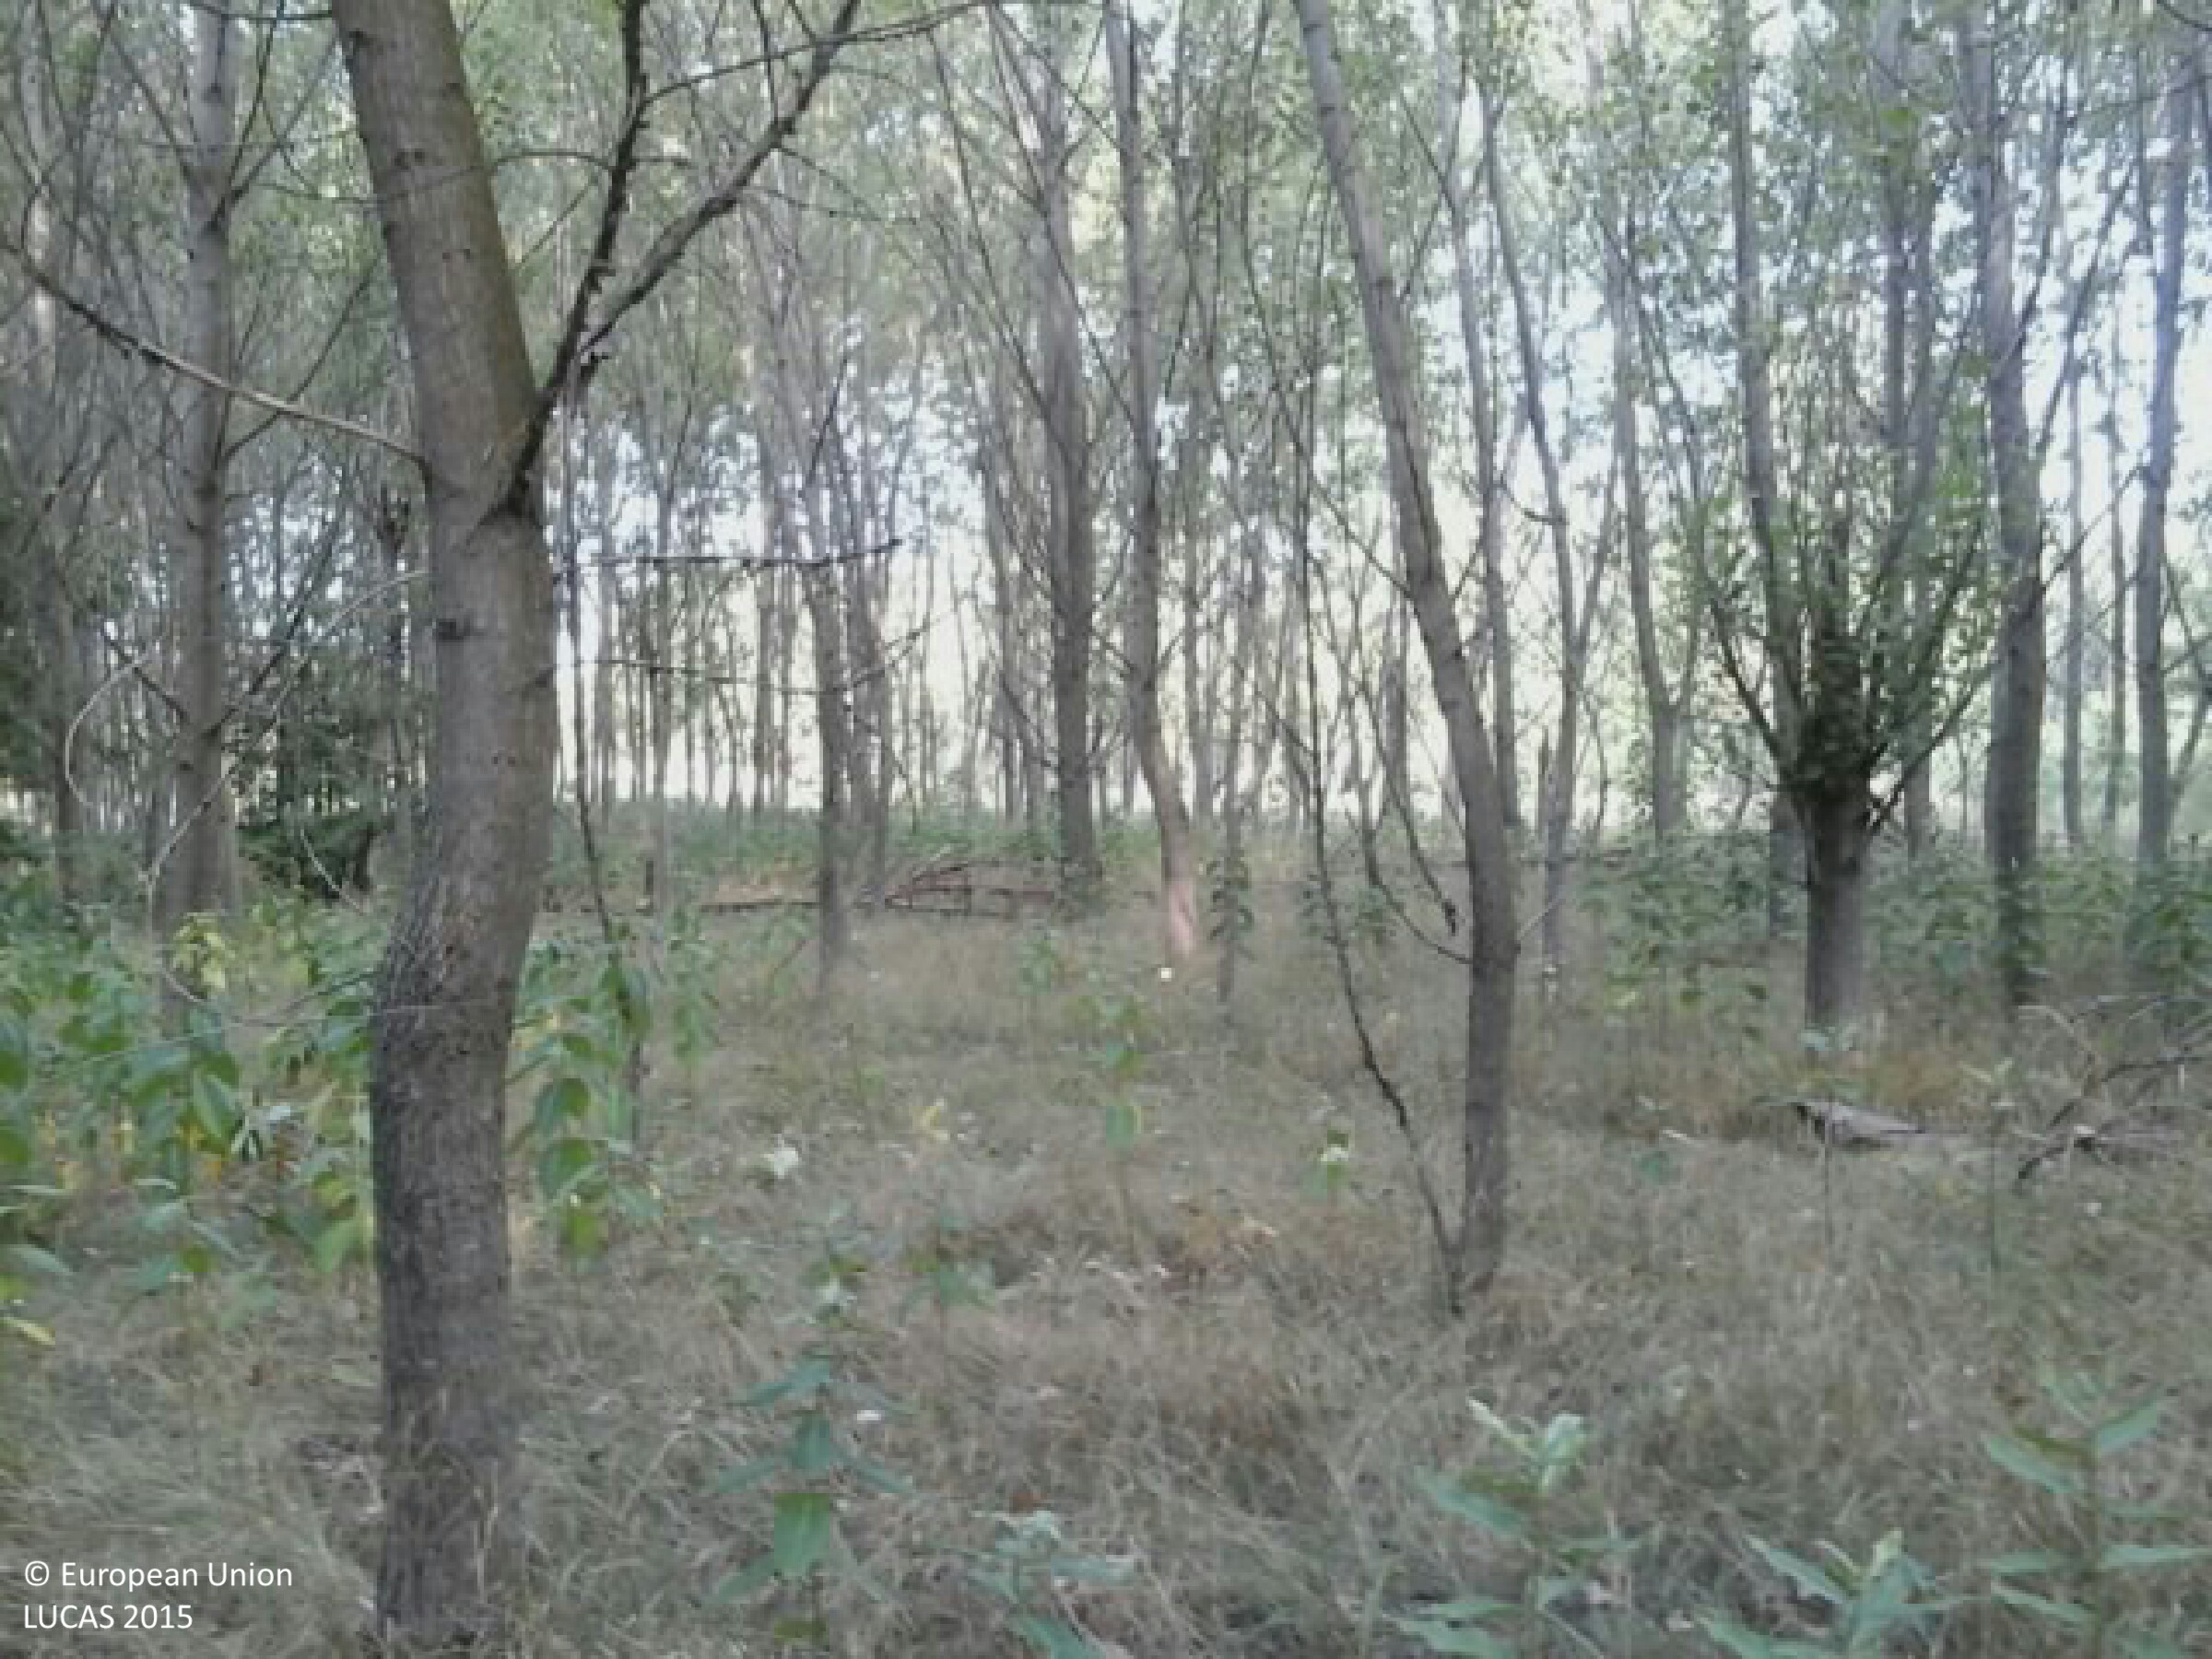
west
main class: Woodland
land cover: Broadleaved woodland
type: mesophytic deciduous forest
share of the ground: > 75 %
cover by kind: broadleaved forest trees 85 %, herbaceous plants 15 %
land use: Forestry
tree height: > 5 m
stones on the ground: < 10 %
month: August
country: HU
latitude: 47.0140
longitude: 19.7163
